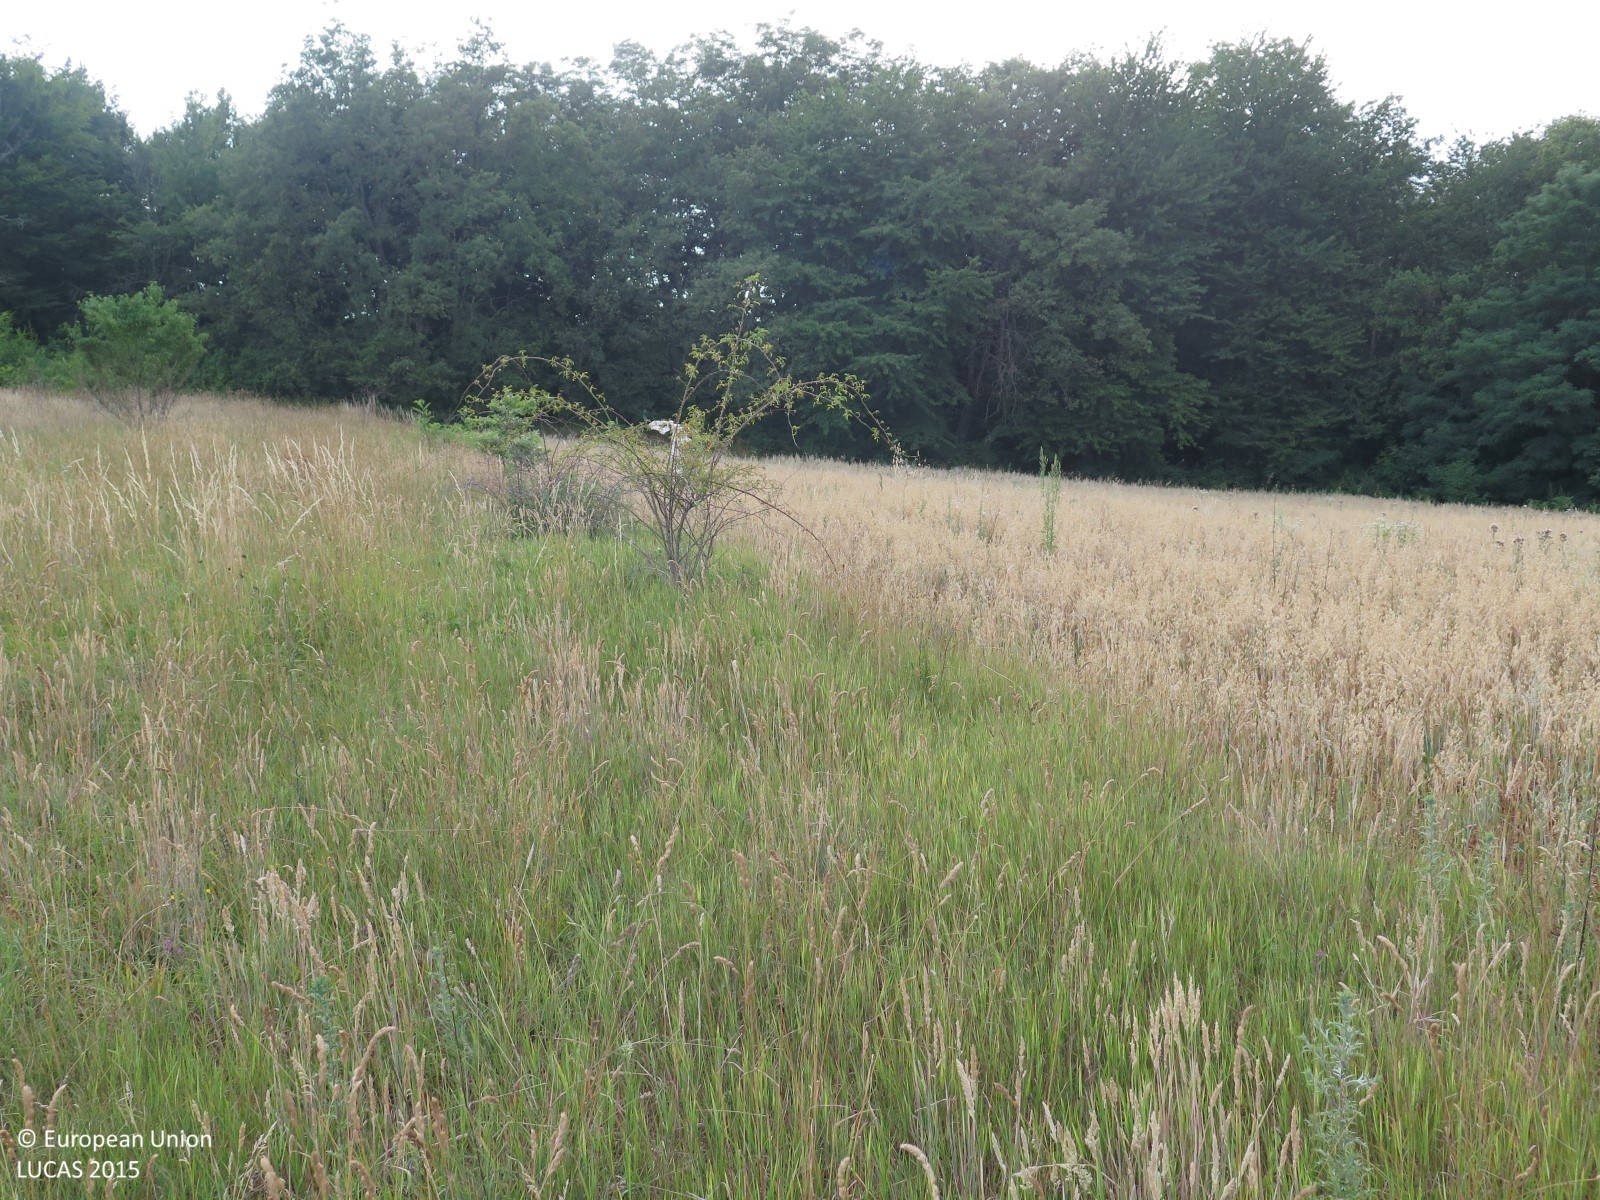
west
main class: Grassland
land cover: Grassland without tree/shrub cover
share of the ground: > 75 %
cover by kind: herbaceous plants 100 %
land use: Agriculture (excluding fallow land and kitchen gardens)
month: July
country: HR
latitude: 45.2545
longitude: 13.8303
